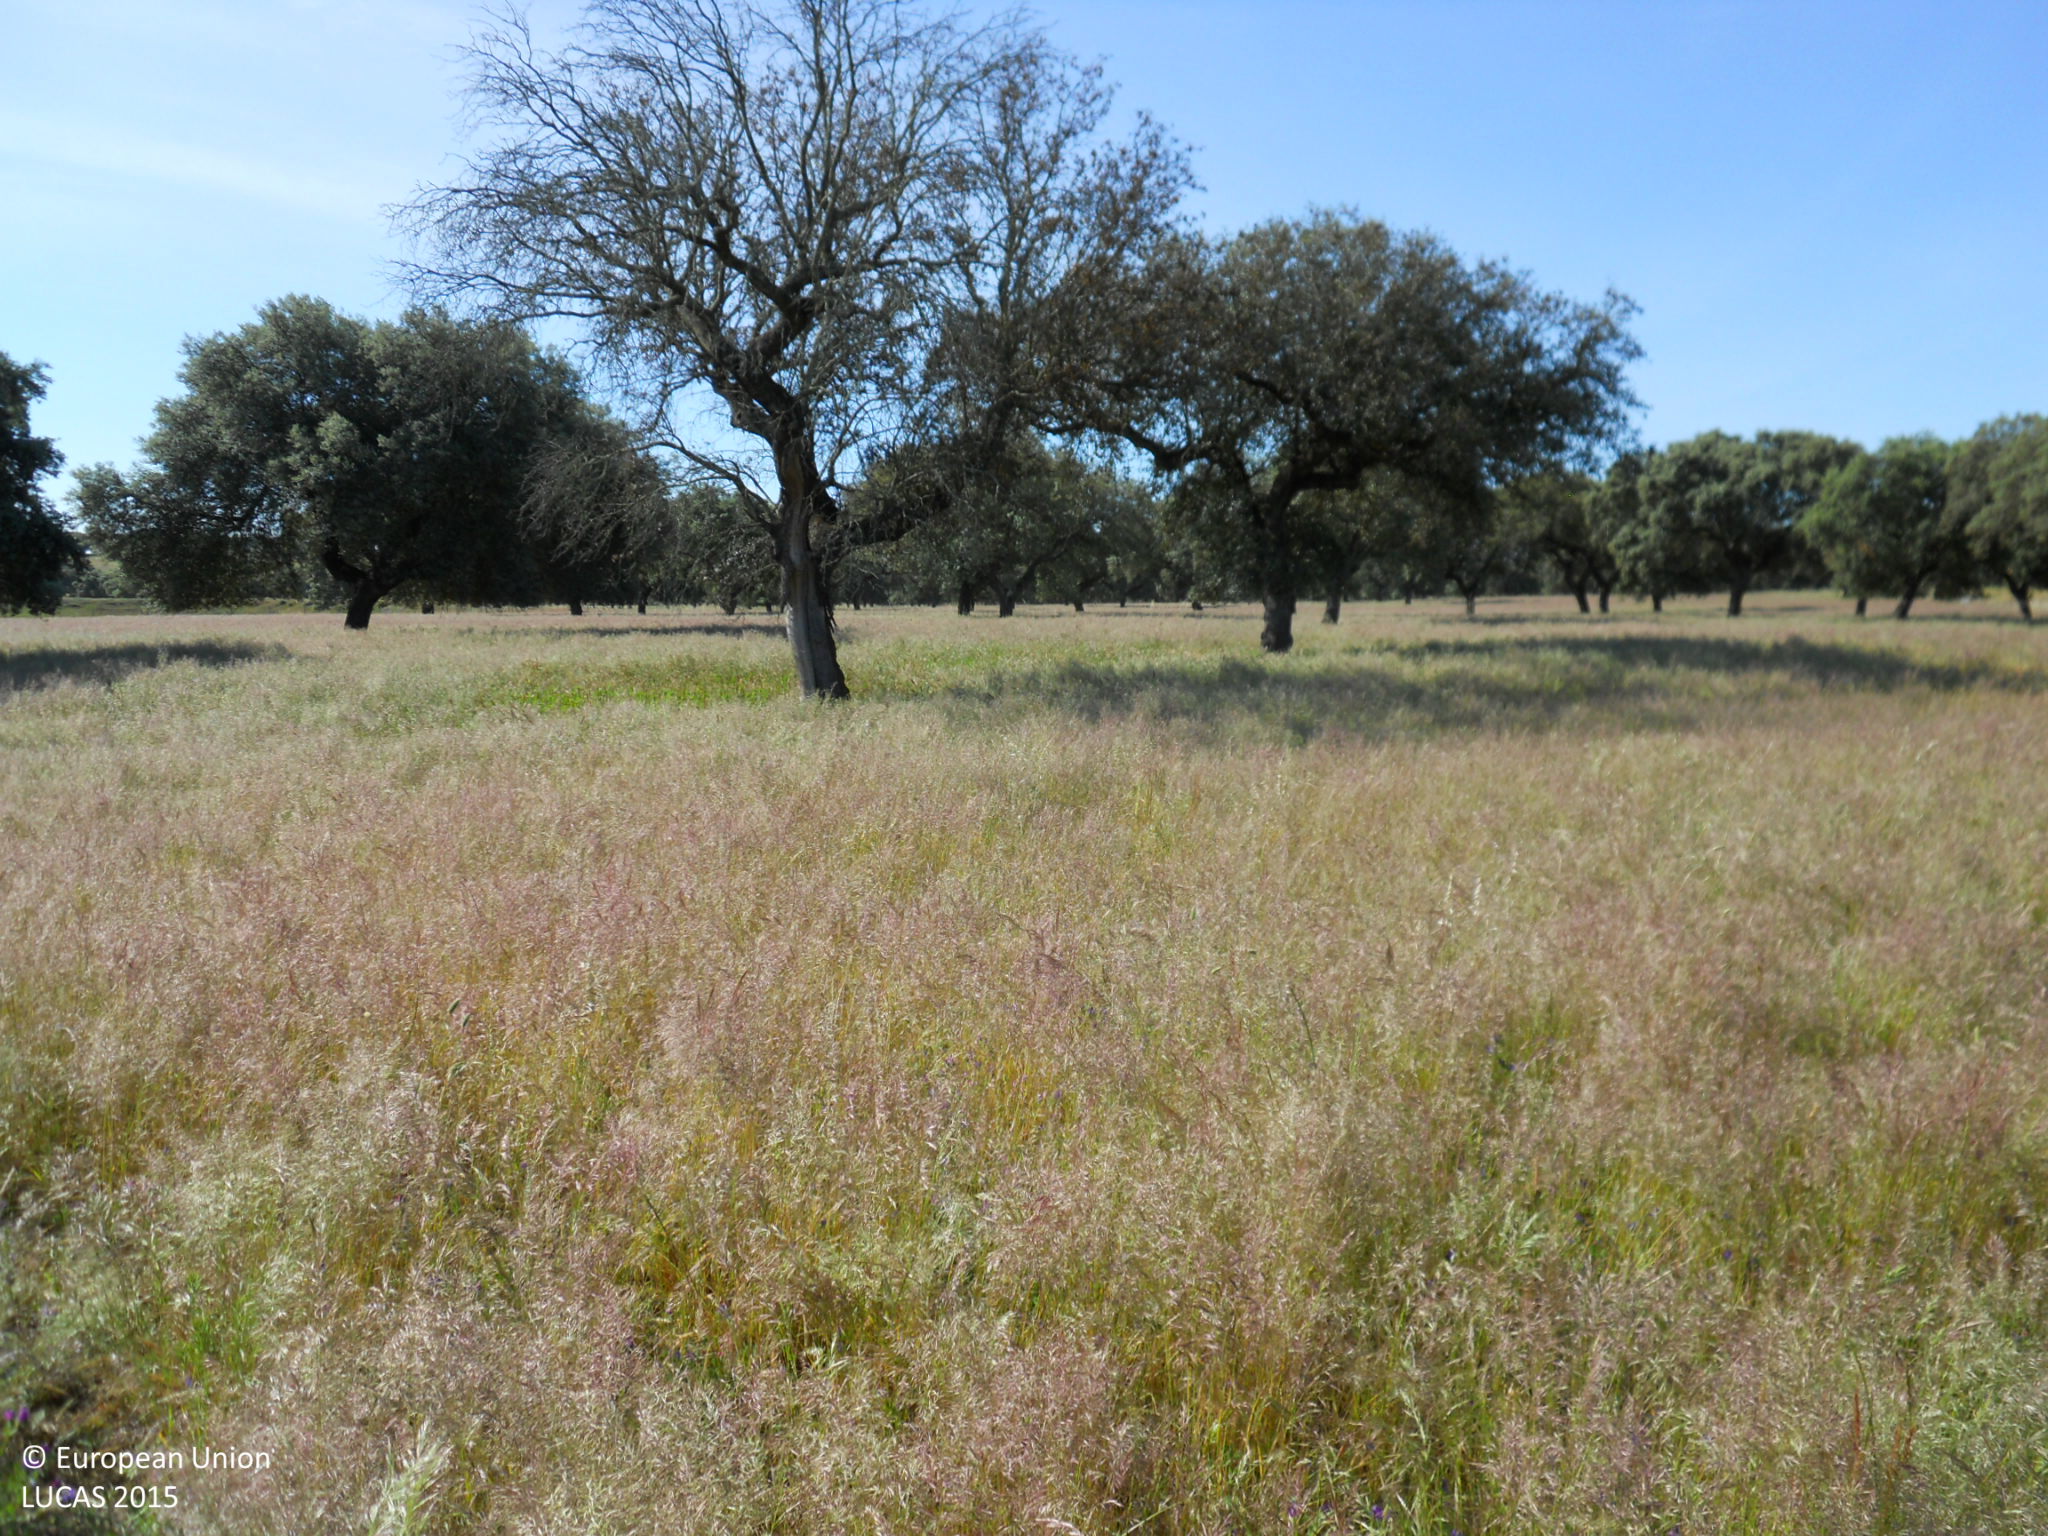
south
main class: Grassland
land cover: Grassland with sparse tree/shrub cover
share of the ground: > 75 %
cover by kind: herbaceous plants 95 %, broadleaved forest trees 5 %
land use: Agriculture (excluding fallow land and kitchen gardens)
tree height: > 5 m
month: April
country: ES
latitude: 39.0543
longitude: -6.8609
